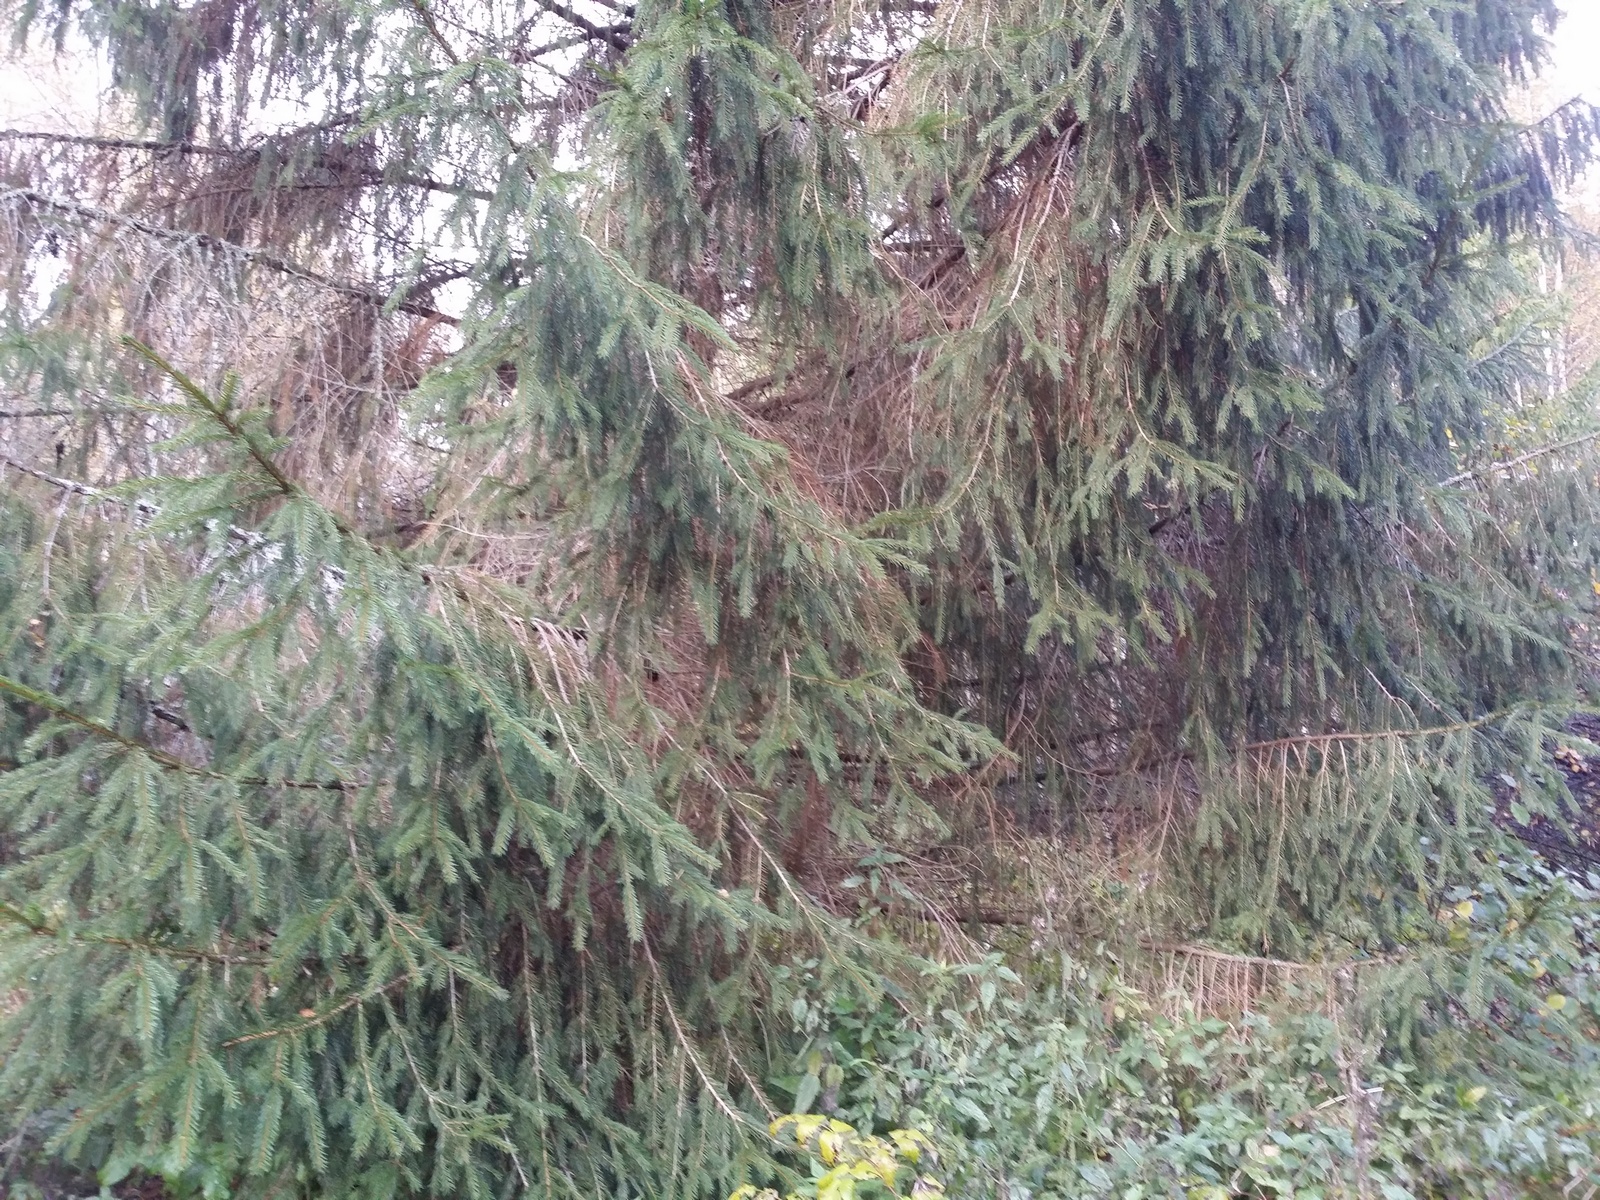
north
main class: Woodland
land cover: Spruce dominated mixed woodland
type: hemiboreal forest and nemoral coniferous forest and mixed broadleaved-coniferous forest
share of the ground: 50 - 75 %
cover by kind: coniferous forest trees 40 %, broadleaved forest trees 25 %, shrubs 15 %, herbaceous plants 10 %, lichens and mosses 10 %
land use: Forestry
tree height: > 5 m
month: September
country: LV
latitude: 57.4944
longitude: 27.4061
